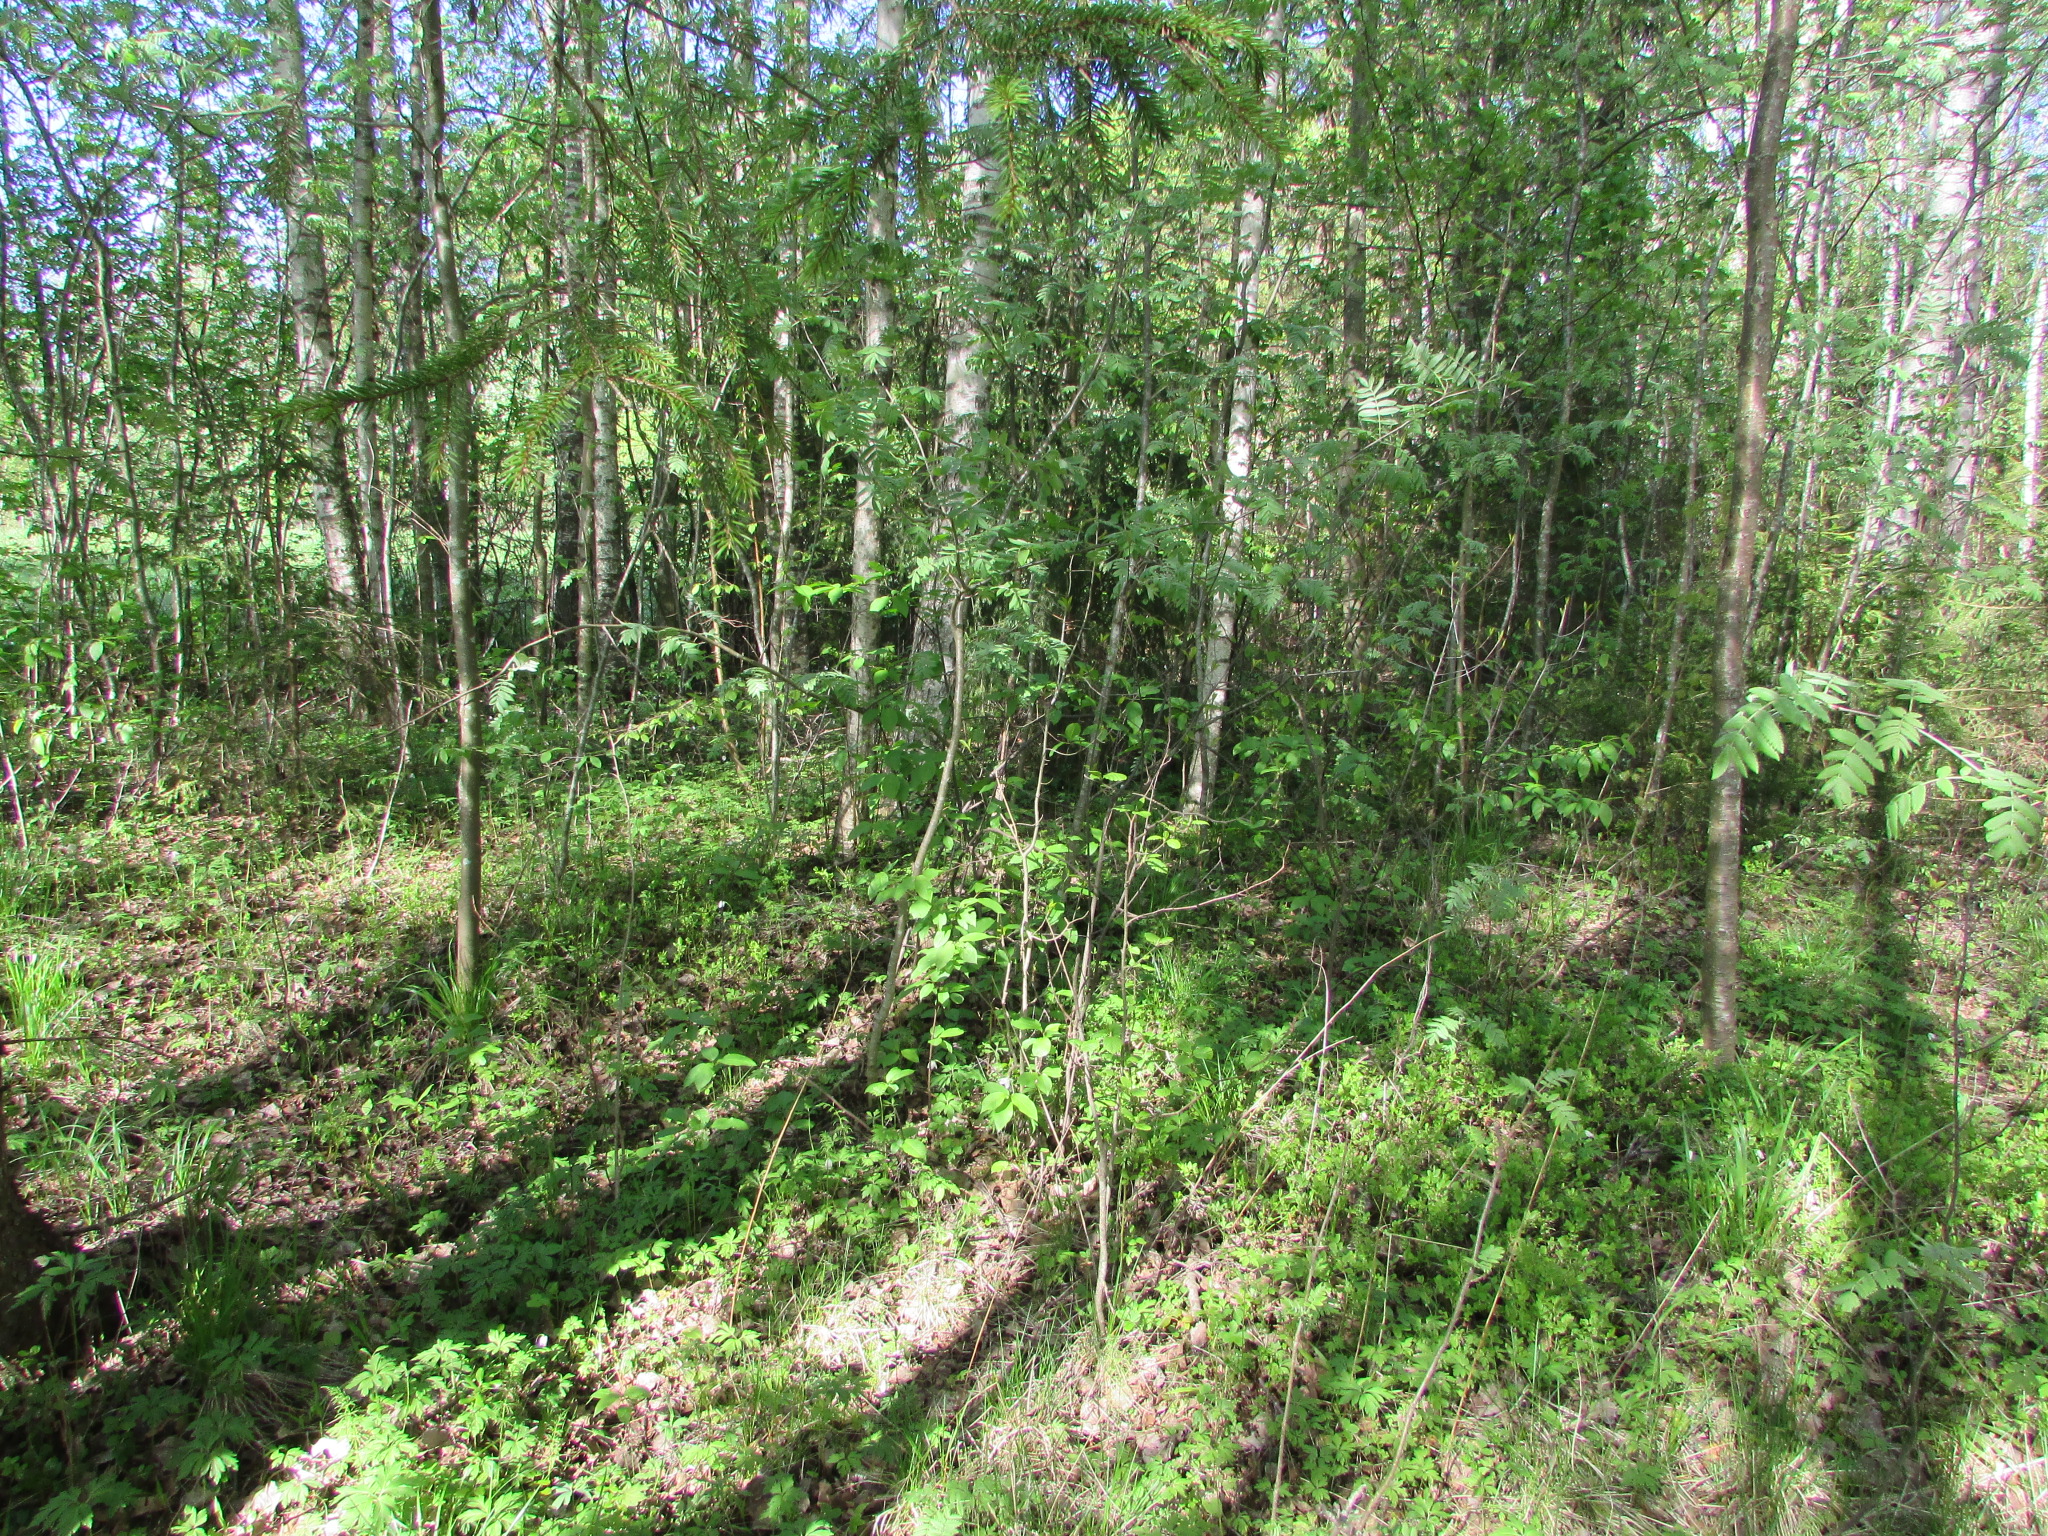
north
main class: Woodland
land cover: Spruce dominated mixed woodland
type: hemiboreal forest and nemoral coniferous forest and mixed broadleaved-coniferous forest
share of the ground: > 75 %
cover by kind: broadleaved forest trees 70 %, coniferous forest trees 30 %
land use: Forestry
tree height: > 5 m
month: May
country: LV
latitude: 56.1139
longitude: 27.1026
